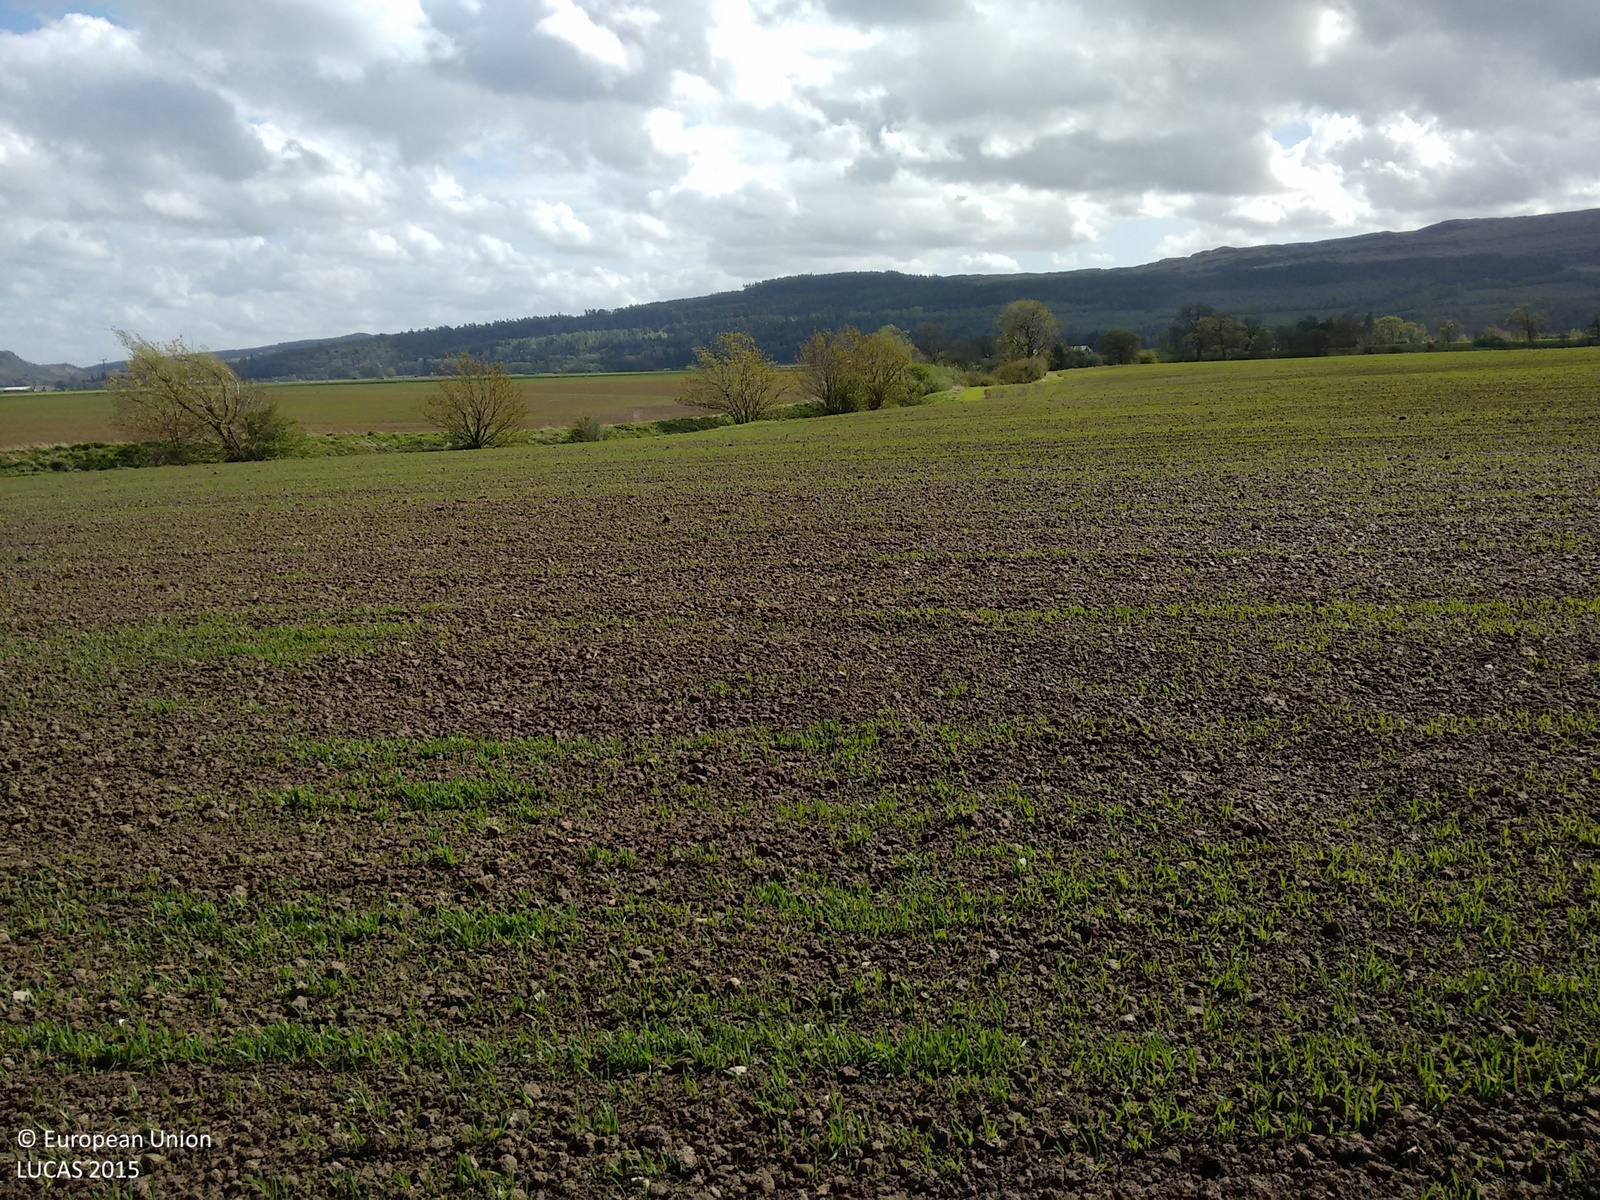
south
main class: Cropland
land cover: Barley
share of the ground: 10 - 25 %
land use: Agriculture (excluding fallow land and kitchen gardens)
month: May
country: GB
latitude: 56.1418
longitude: -4.0408
